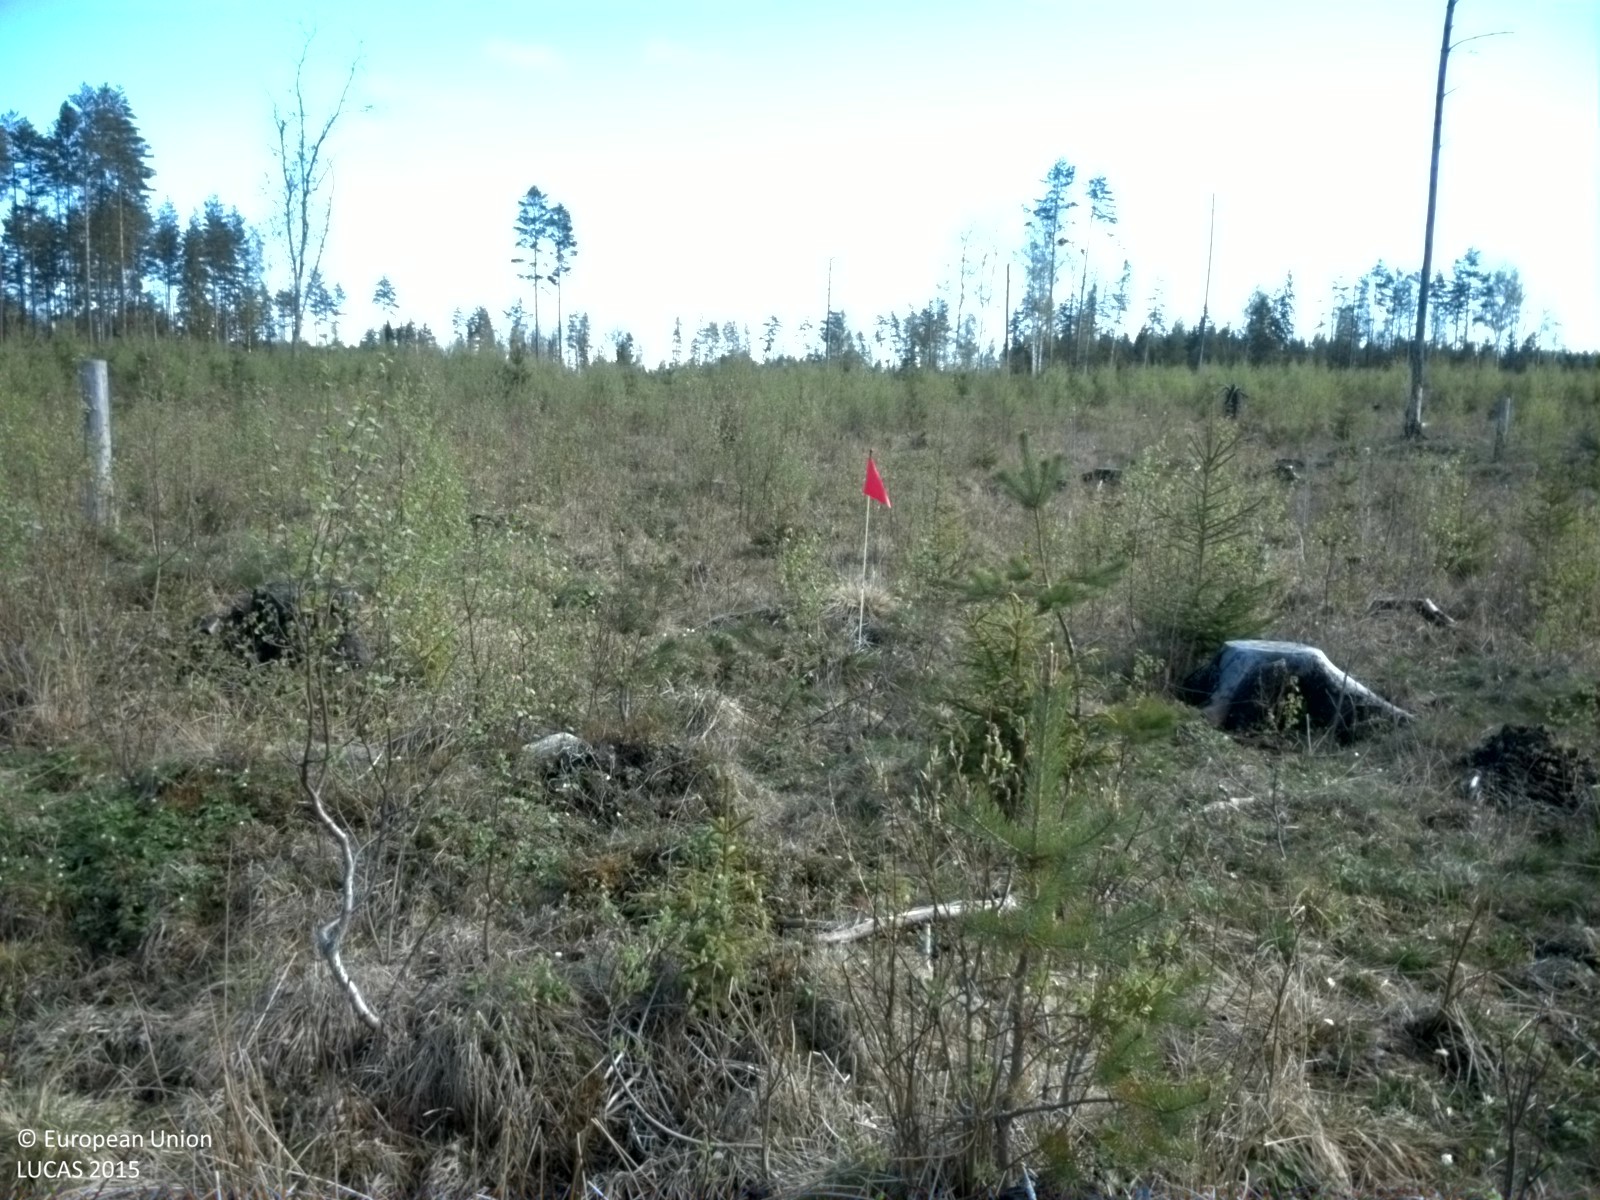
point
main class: Woodland
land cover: Broadleaved woodland
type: boreal forest
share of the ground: 25 - 50 %
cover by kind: broadleaved forest trees 45 %, herbaceous plants 40 %, shrubs 10 %, coniferous forest trees 5 %
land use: Forestry
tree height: < 5 m
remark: Clear cut
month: May
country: SE
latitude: 60.1520
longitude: 18.0102
